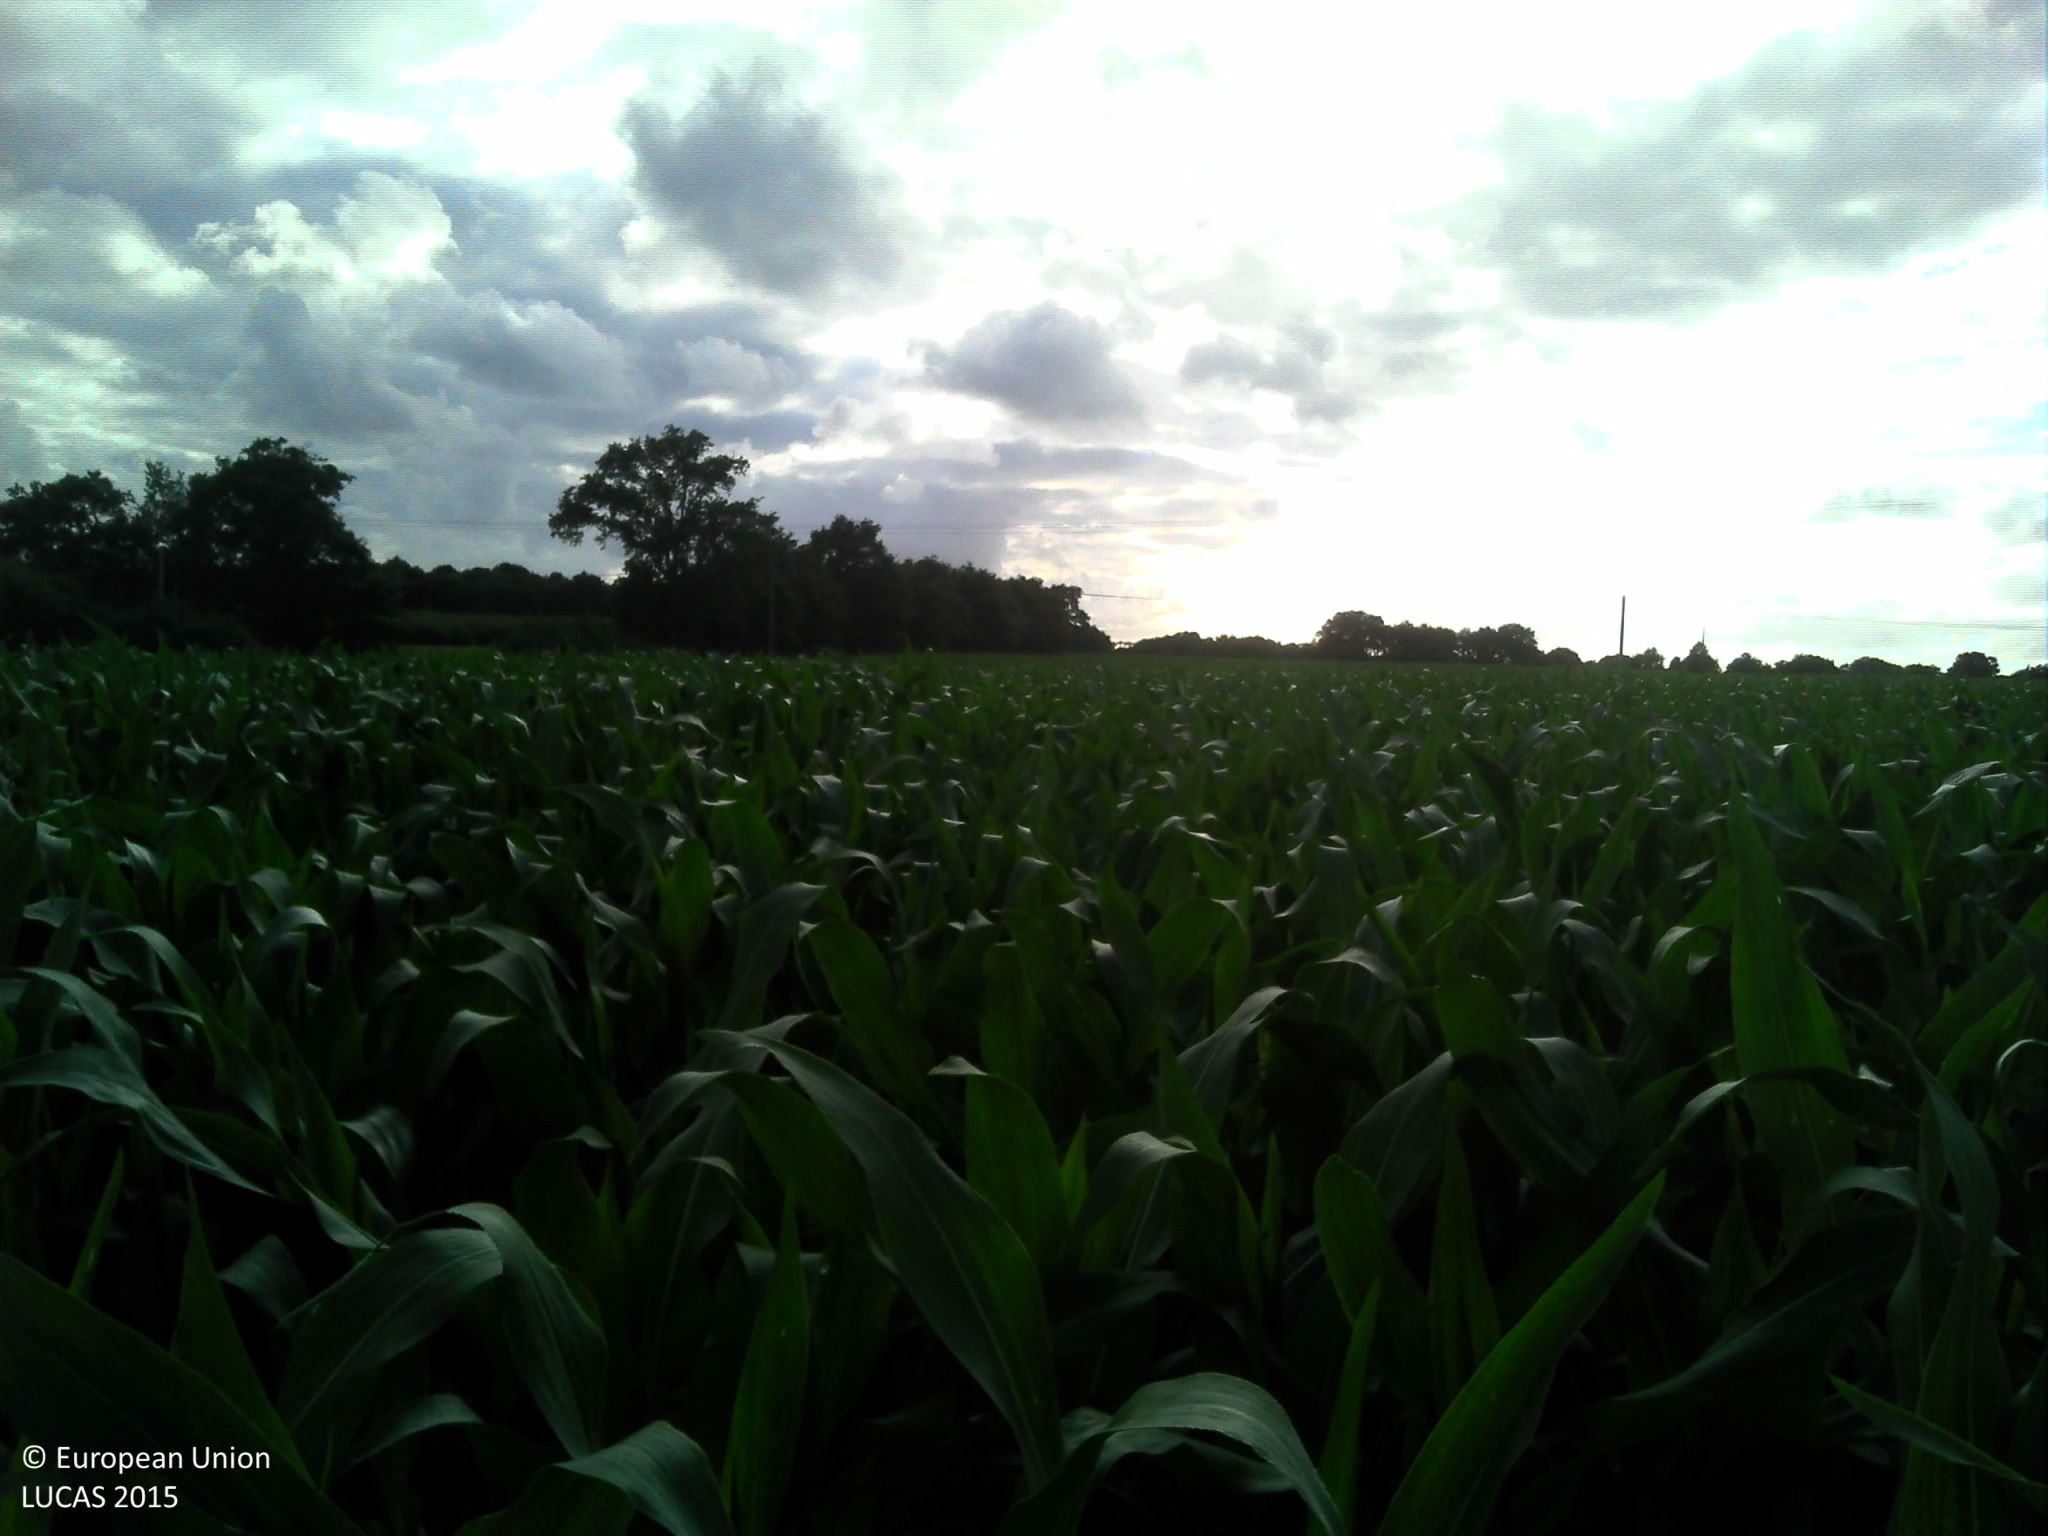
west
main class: Cropland
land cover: Maize
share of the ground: > 75 %
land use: Agriculture (excluding fallow land and kitchen gardens)
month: July
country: FR
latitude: 46.4973
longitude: -1.6227
